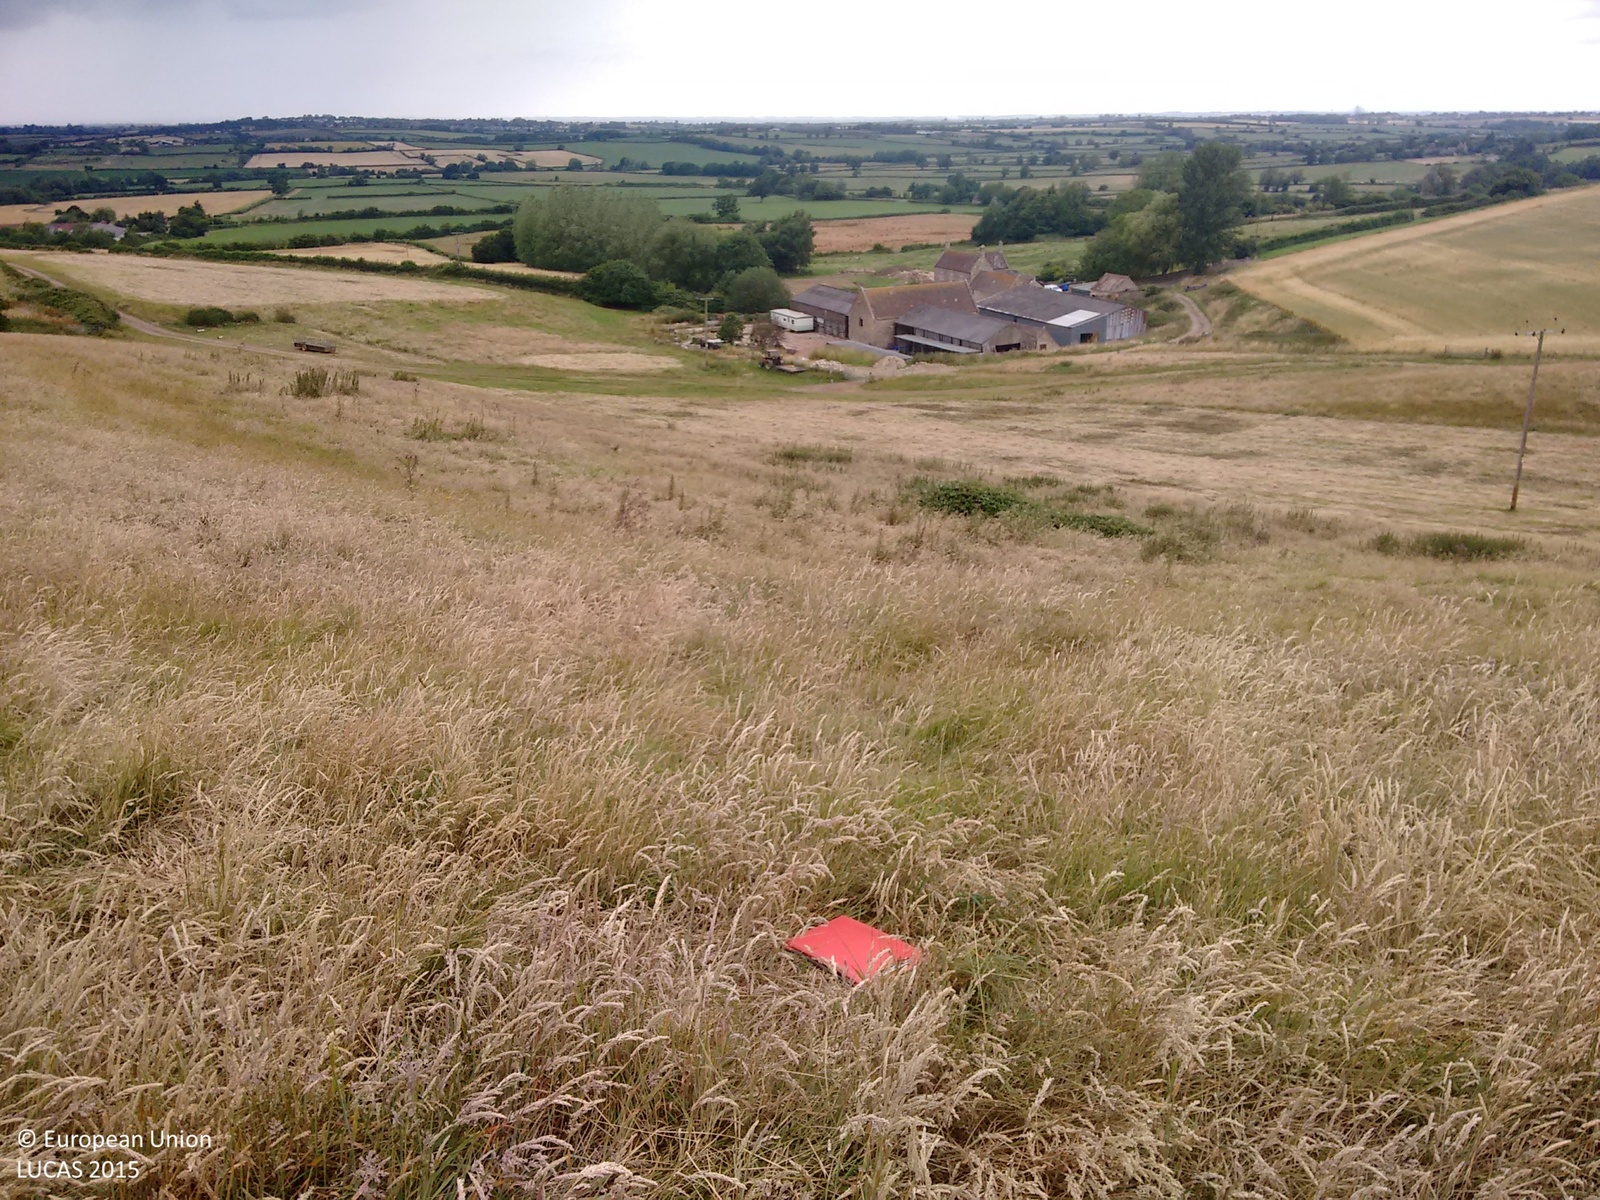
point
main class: Grassland
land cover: Grassland without tree/shrub cover
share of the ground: > 75 %
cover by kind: herbaceous plants 100 %
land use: Agriculture (excluding fallow land and kitchen gardens)
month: July
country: GB
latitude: 51.4723
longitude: -2.3736
